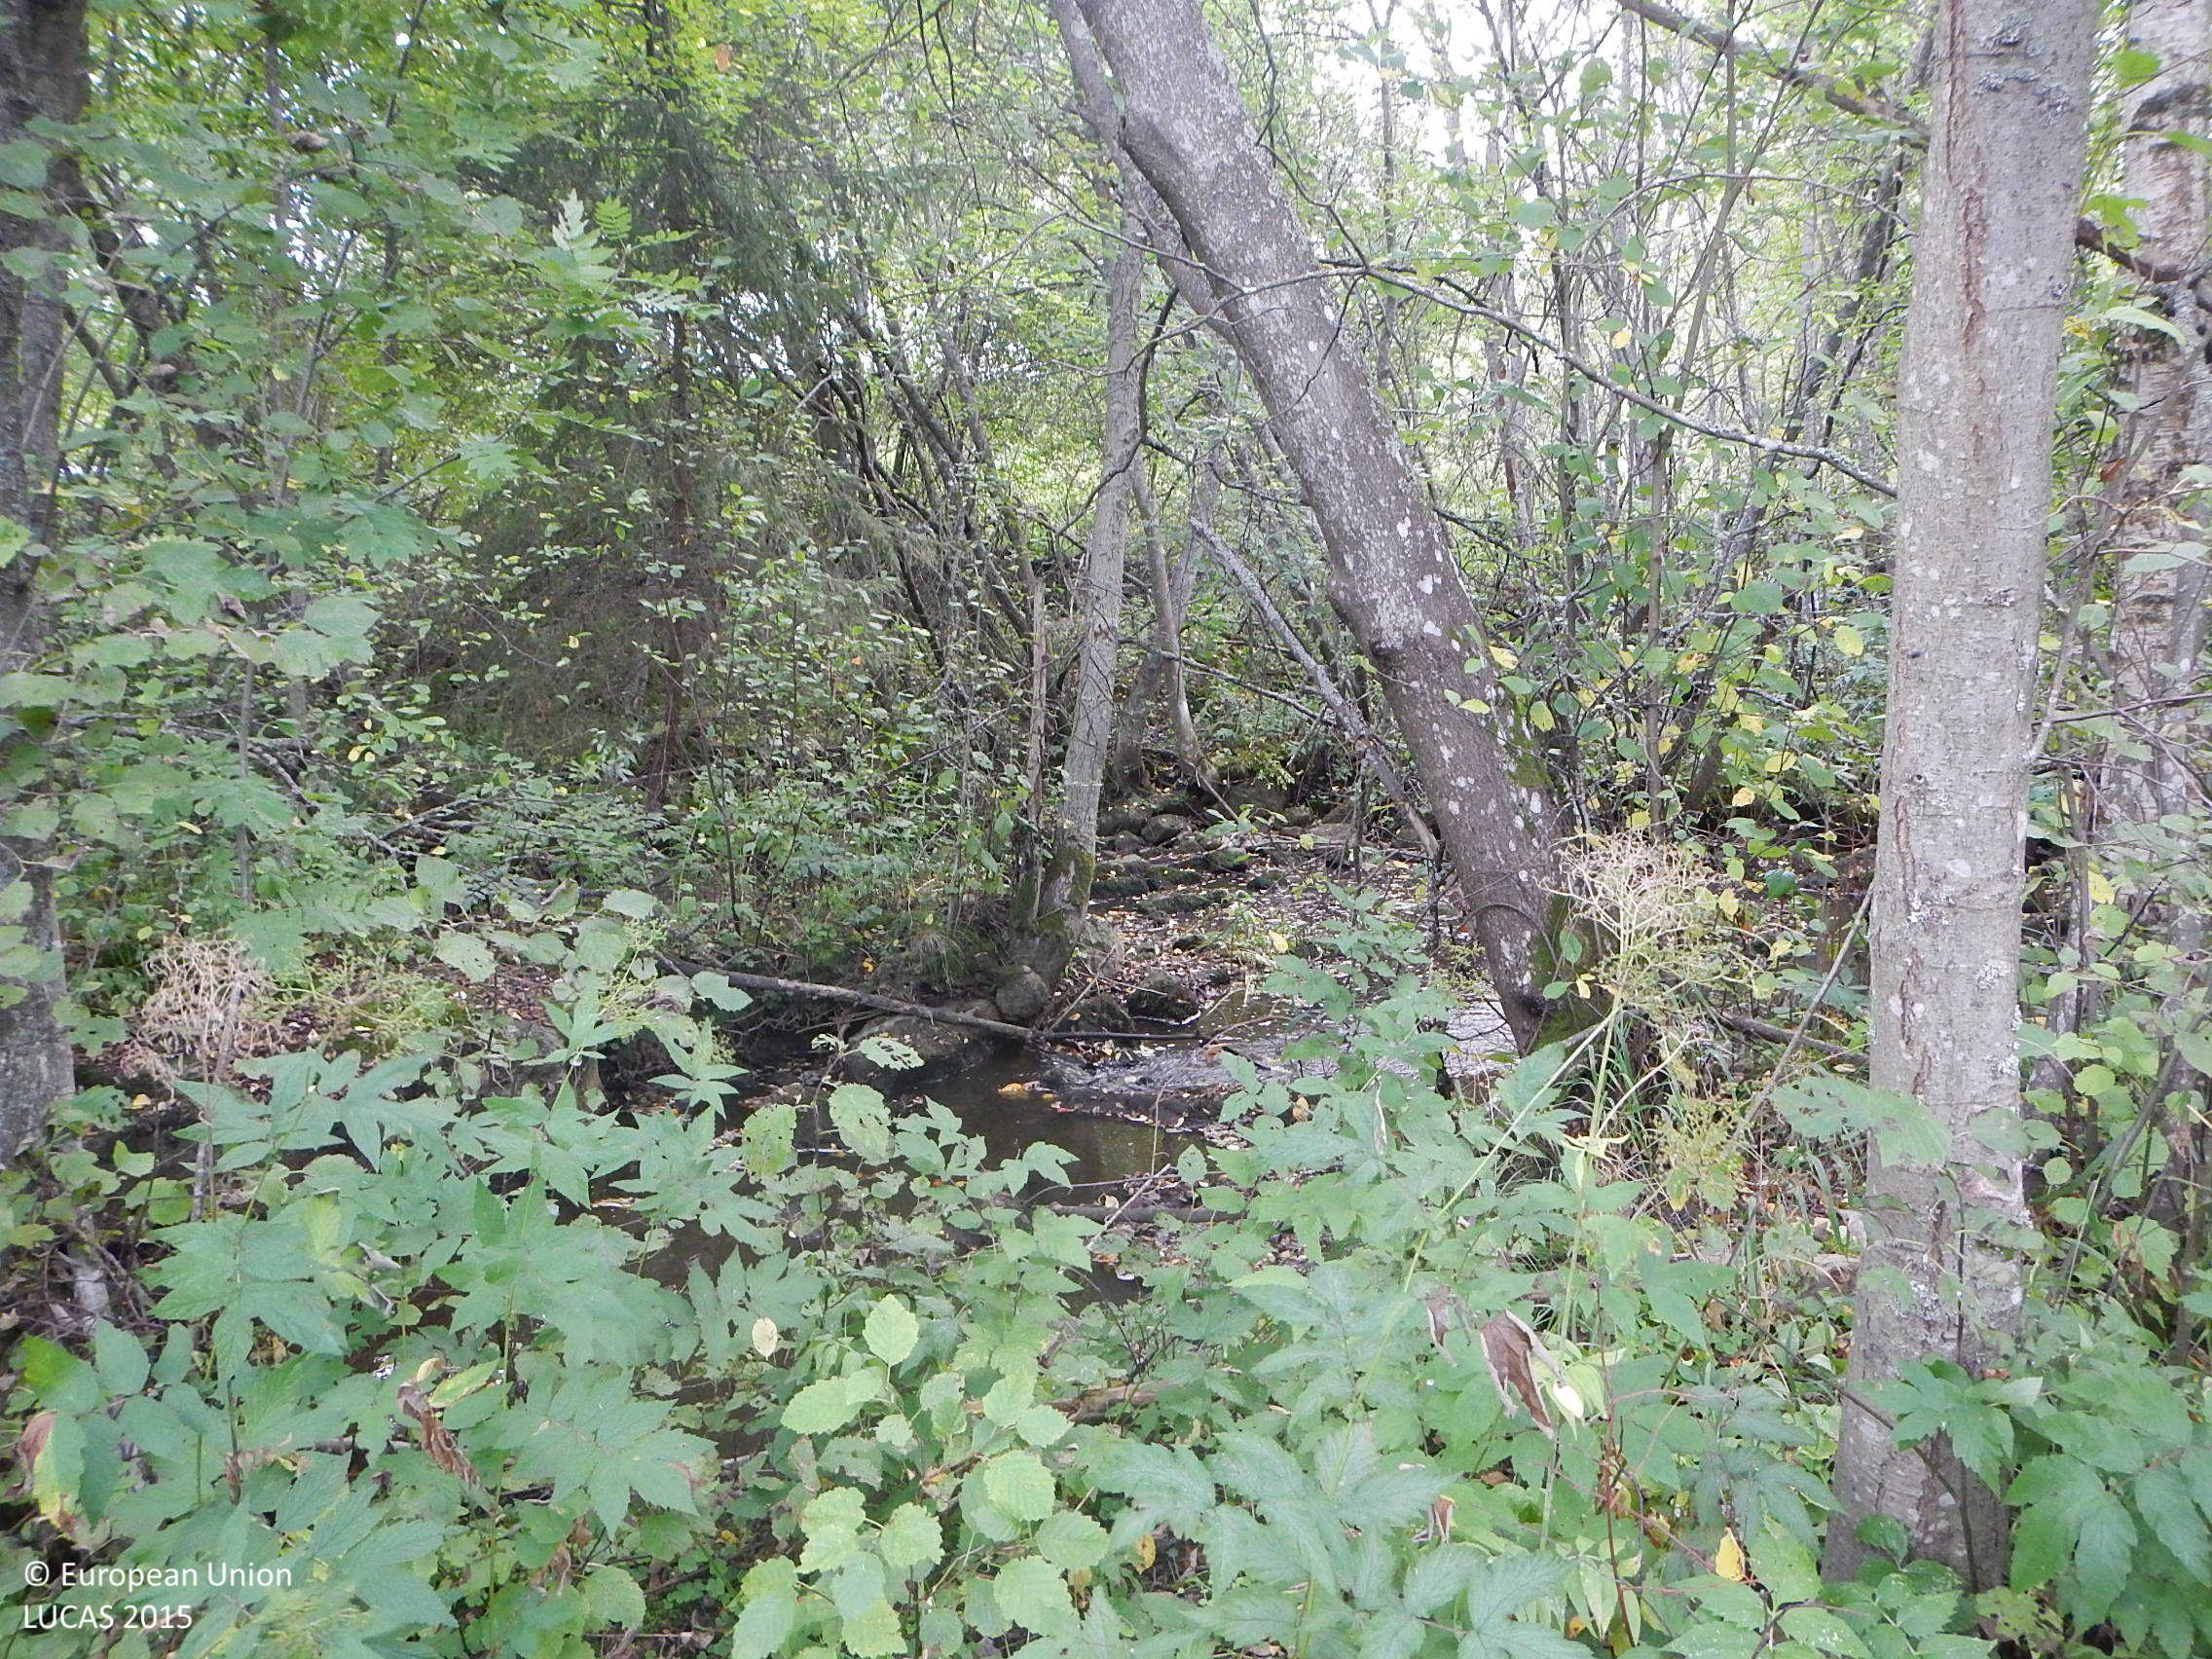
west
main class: Woodland
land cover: Broadleaved woodland
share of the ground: > 75 %
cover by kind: broadleaved forest trees 90 %, shrubs 10 %
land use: Semi-natural and natural areas not in use
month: September
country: FI
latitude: 61.4541
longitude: 22.0065
